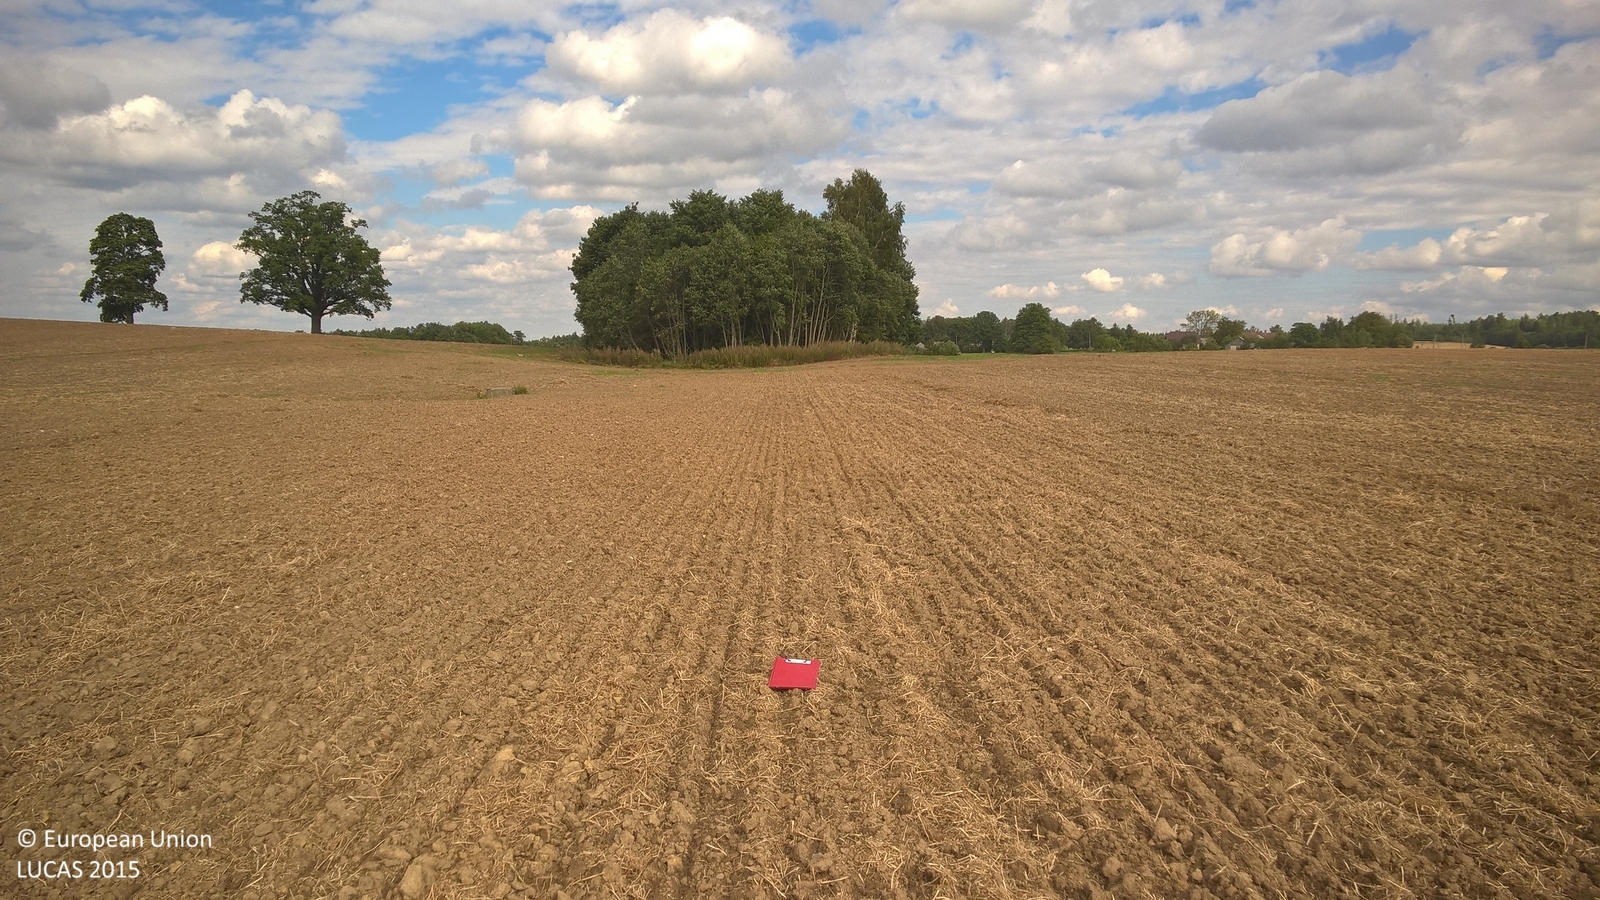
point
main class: Cropland
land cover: Dry pulses
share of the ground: < 10 %
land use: Agriculture (excluding fallow land and kitchen gardens)
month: September
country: LV
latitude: 57.3248
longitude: 25.5458
